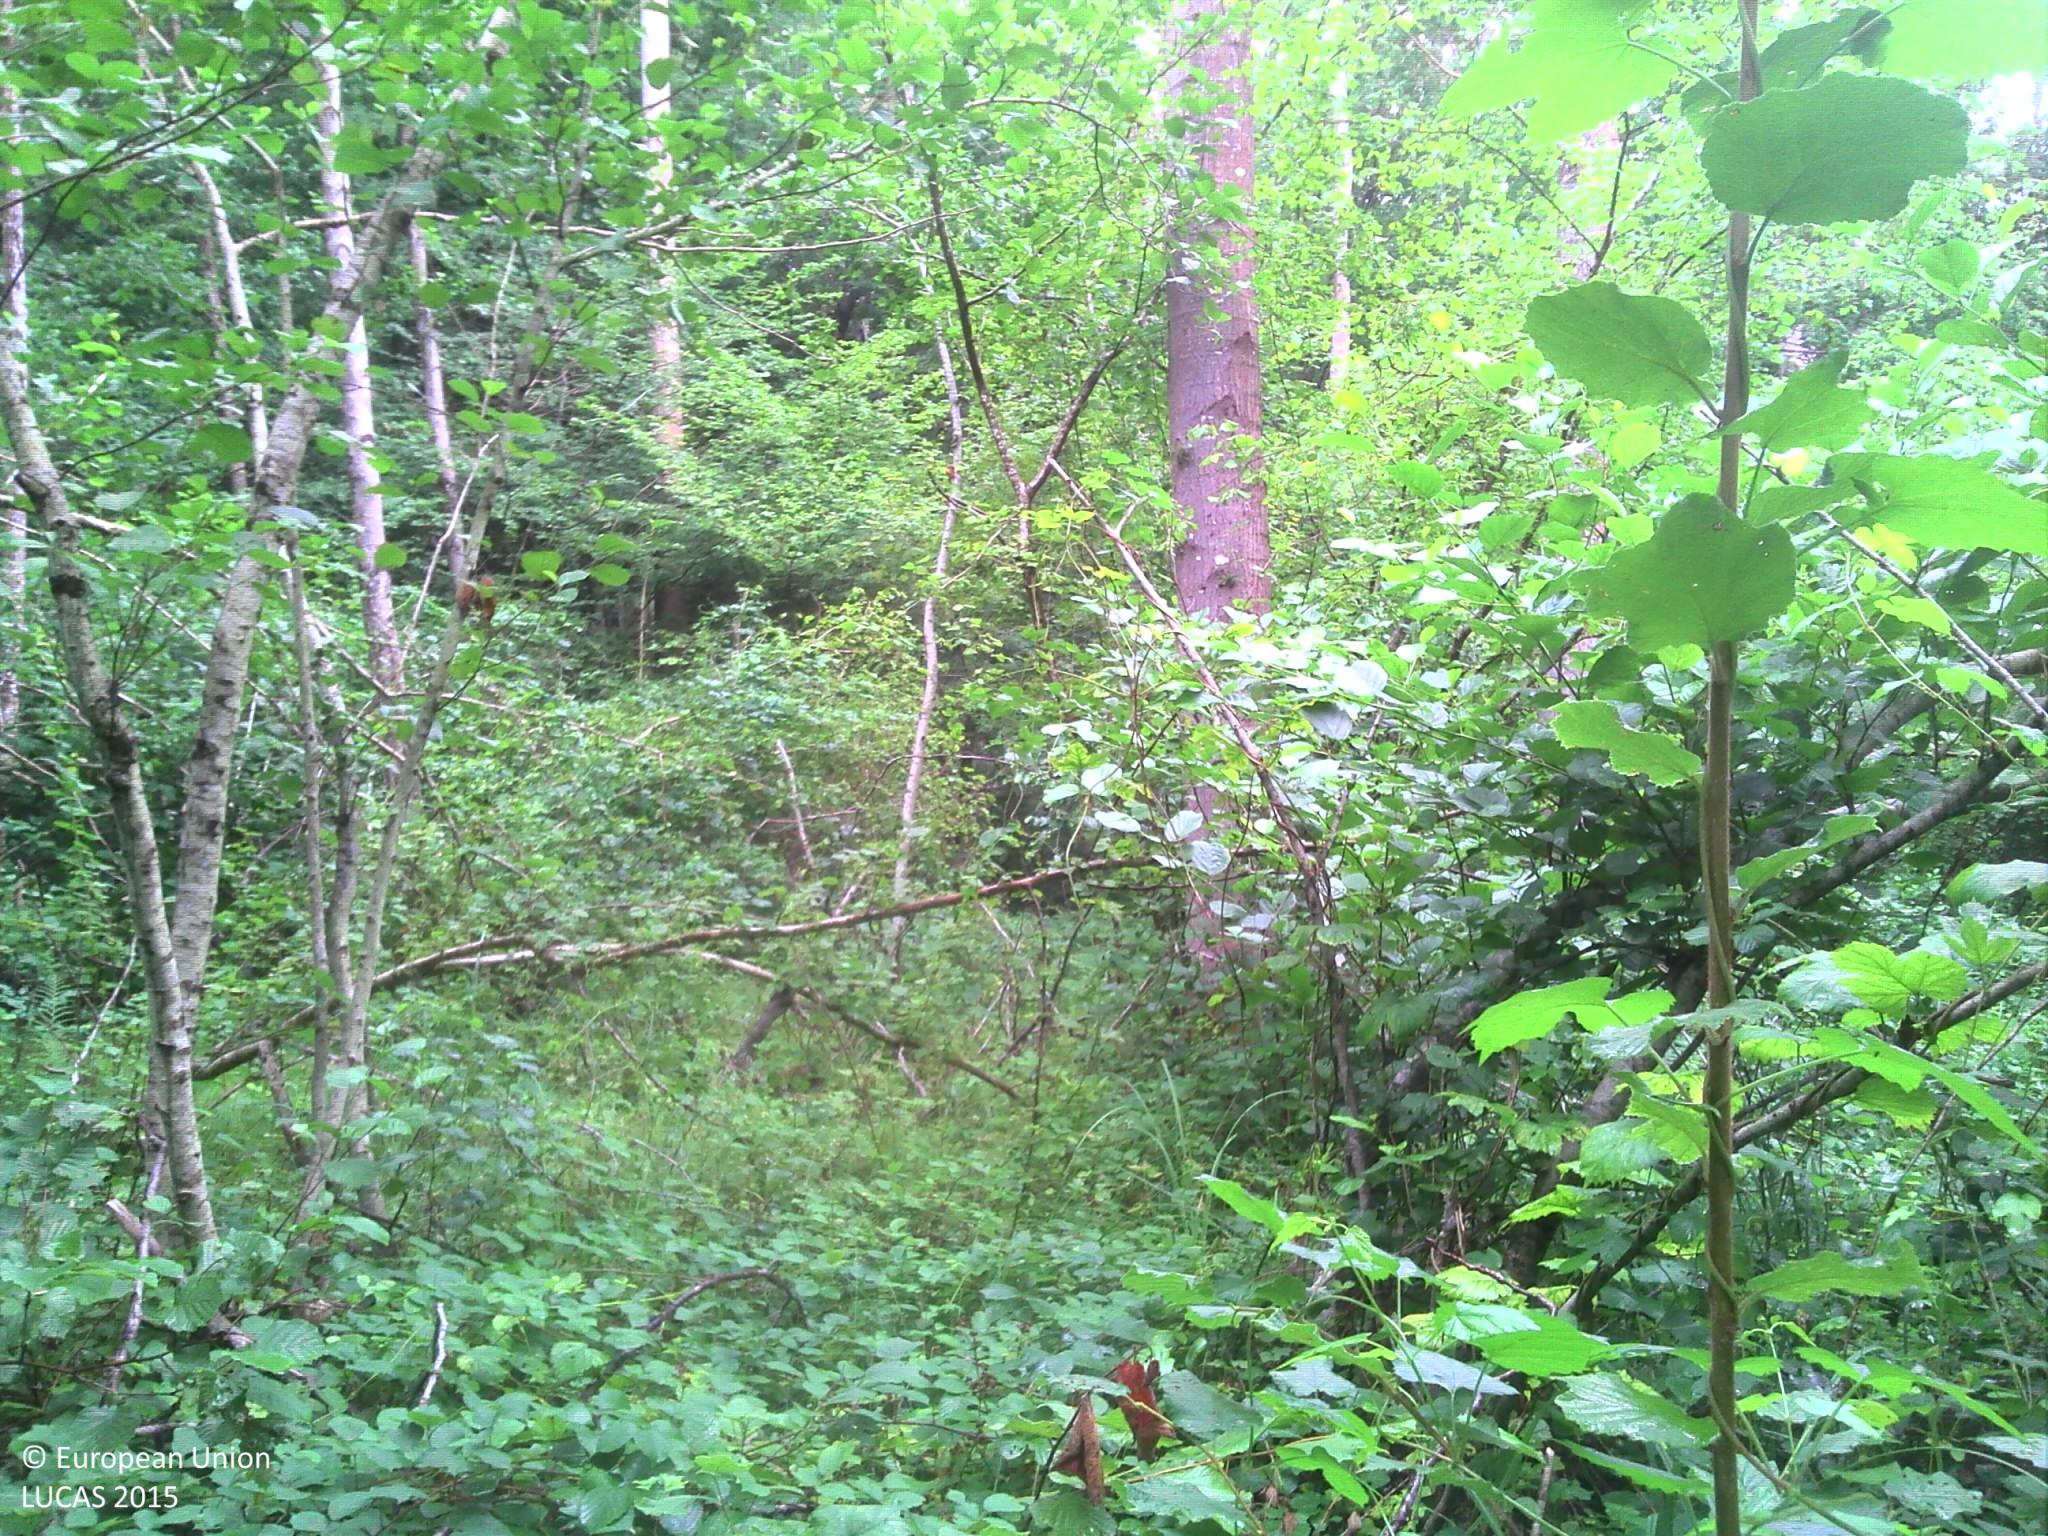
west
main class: Woodland
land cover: Broadleaved woodland
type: non-riverine alder, birch or aspen forest
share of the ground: > 75 %
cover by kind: broadleaved forest trees 75 %, herbaceous plants 20 %, shrubs 5 %
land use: Forestry
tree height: > 5 m
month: July
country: FR
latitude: 46.7223
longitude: 5.0168
